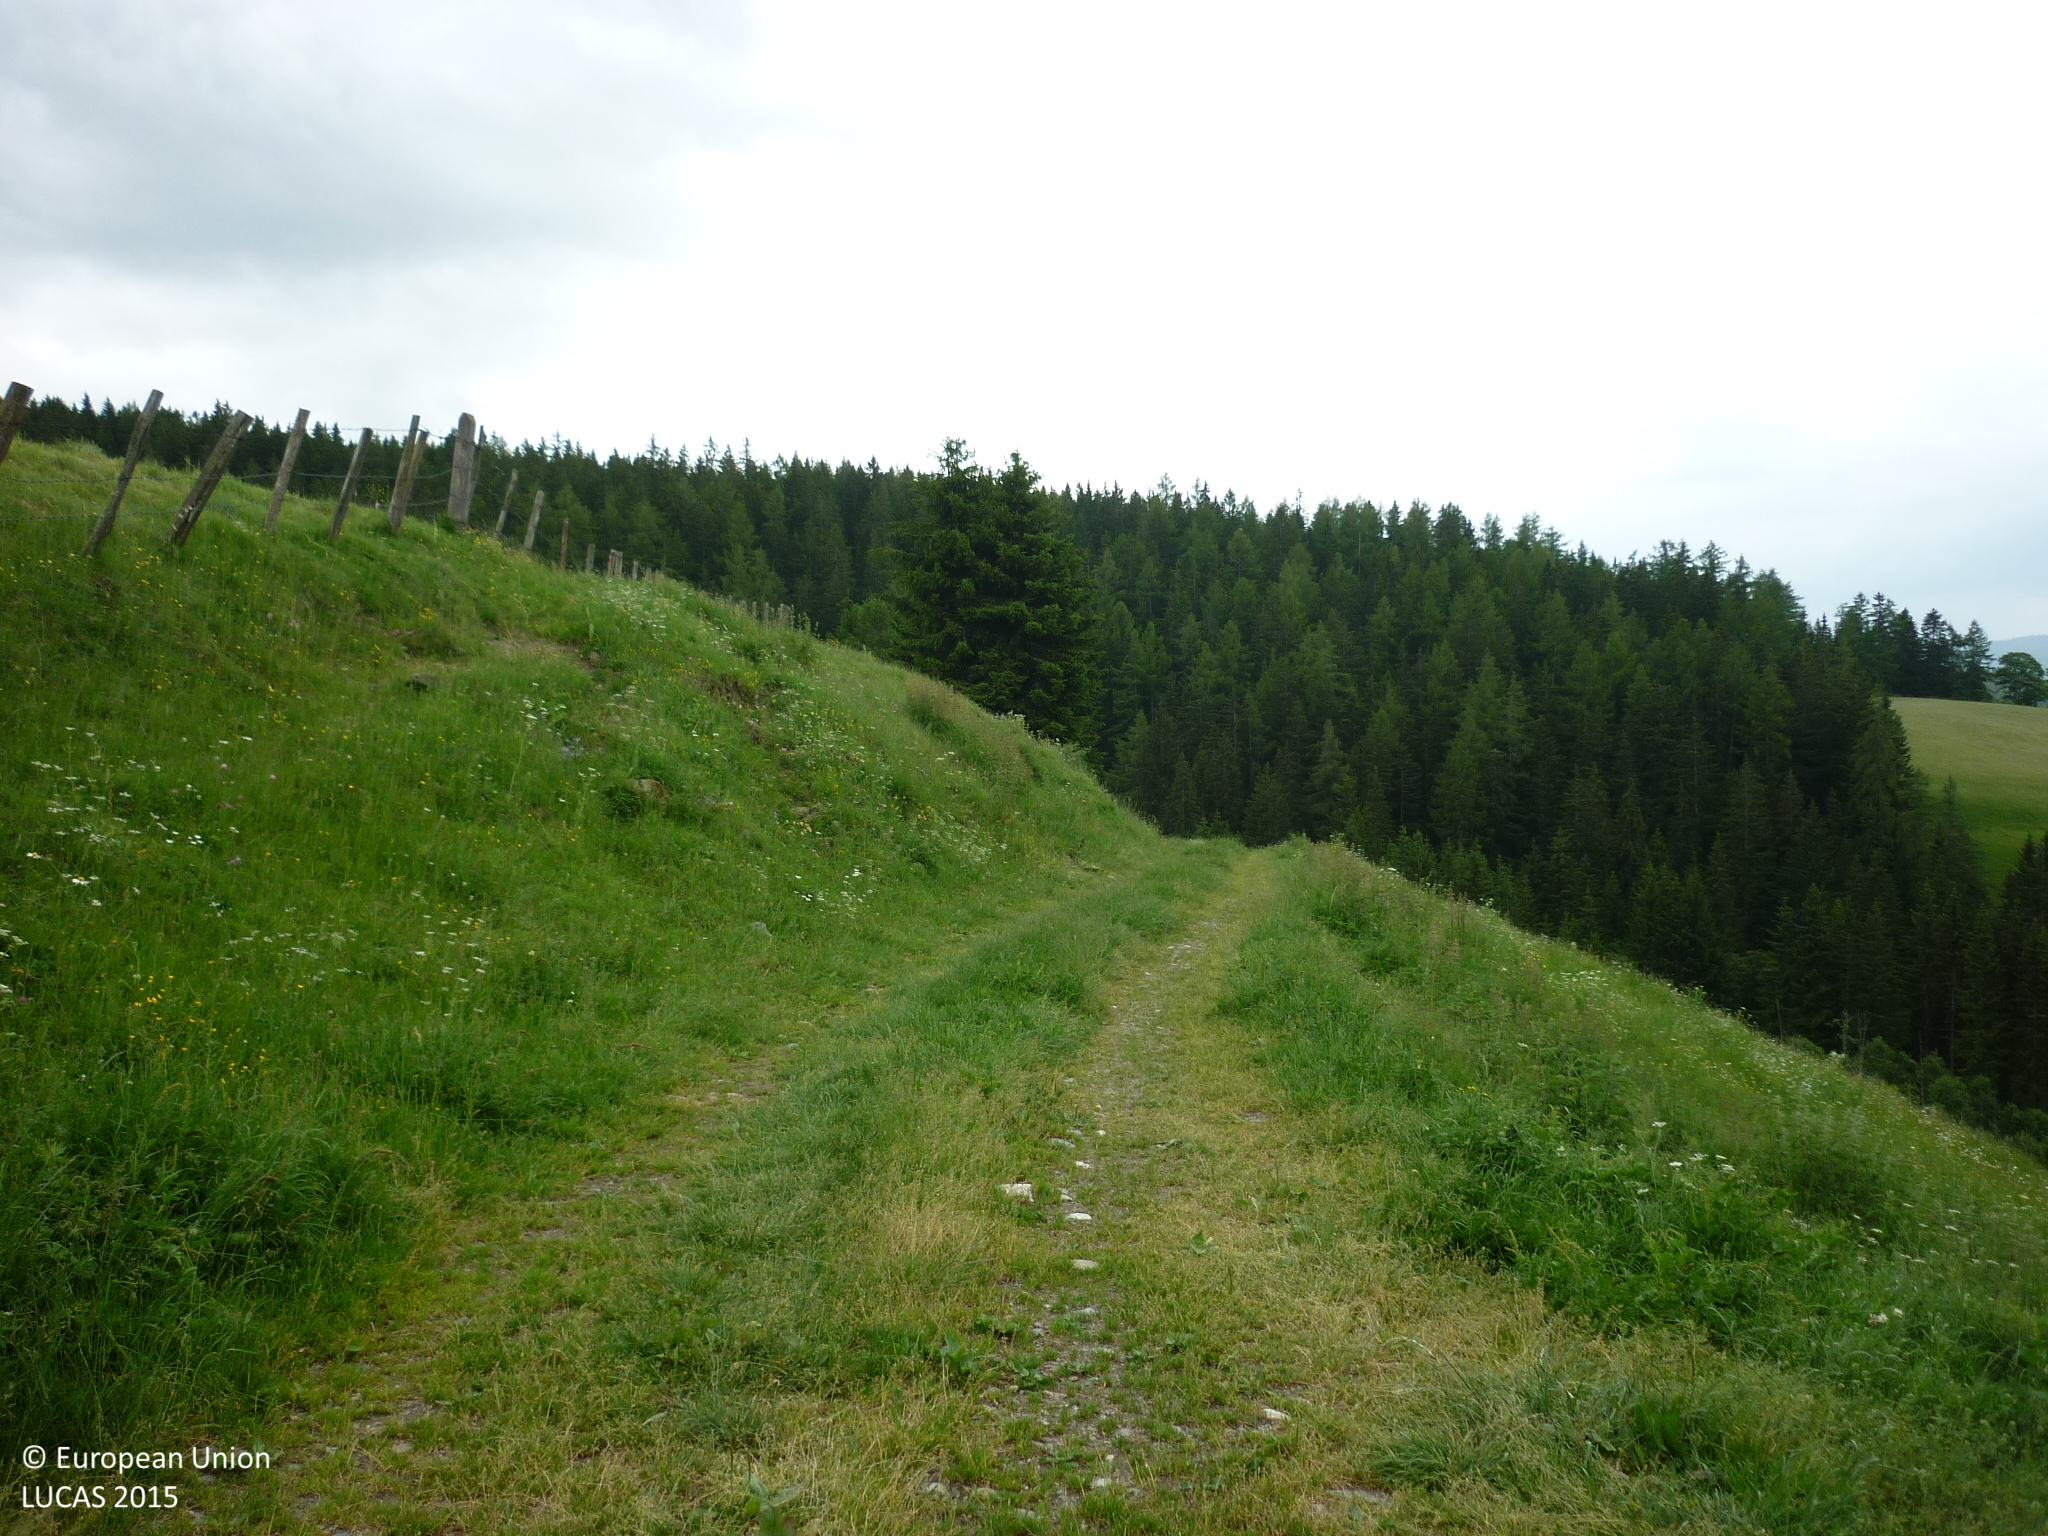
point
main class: Grassland
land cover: Grassland without tree/shrub cover
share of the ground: > 75 %
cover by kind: herbaceous plants 100 %
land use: Agriculture (excluding fallow land and kitchen gardens)
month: June
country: AT
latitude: 47.0866
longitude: 14.4902
